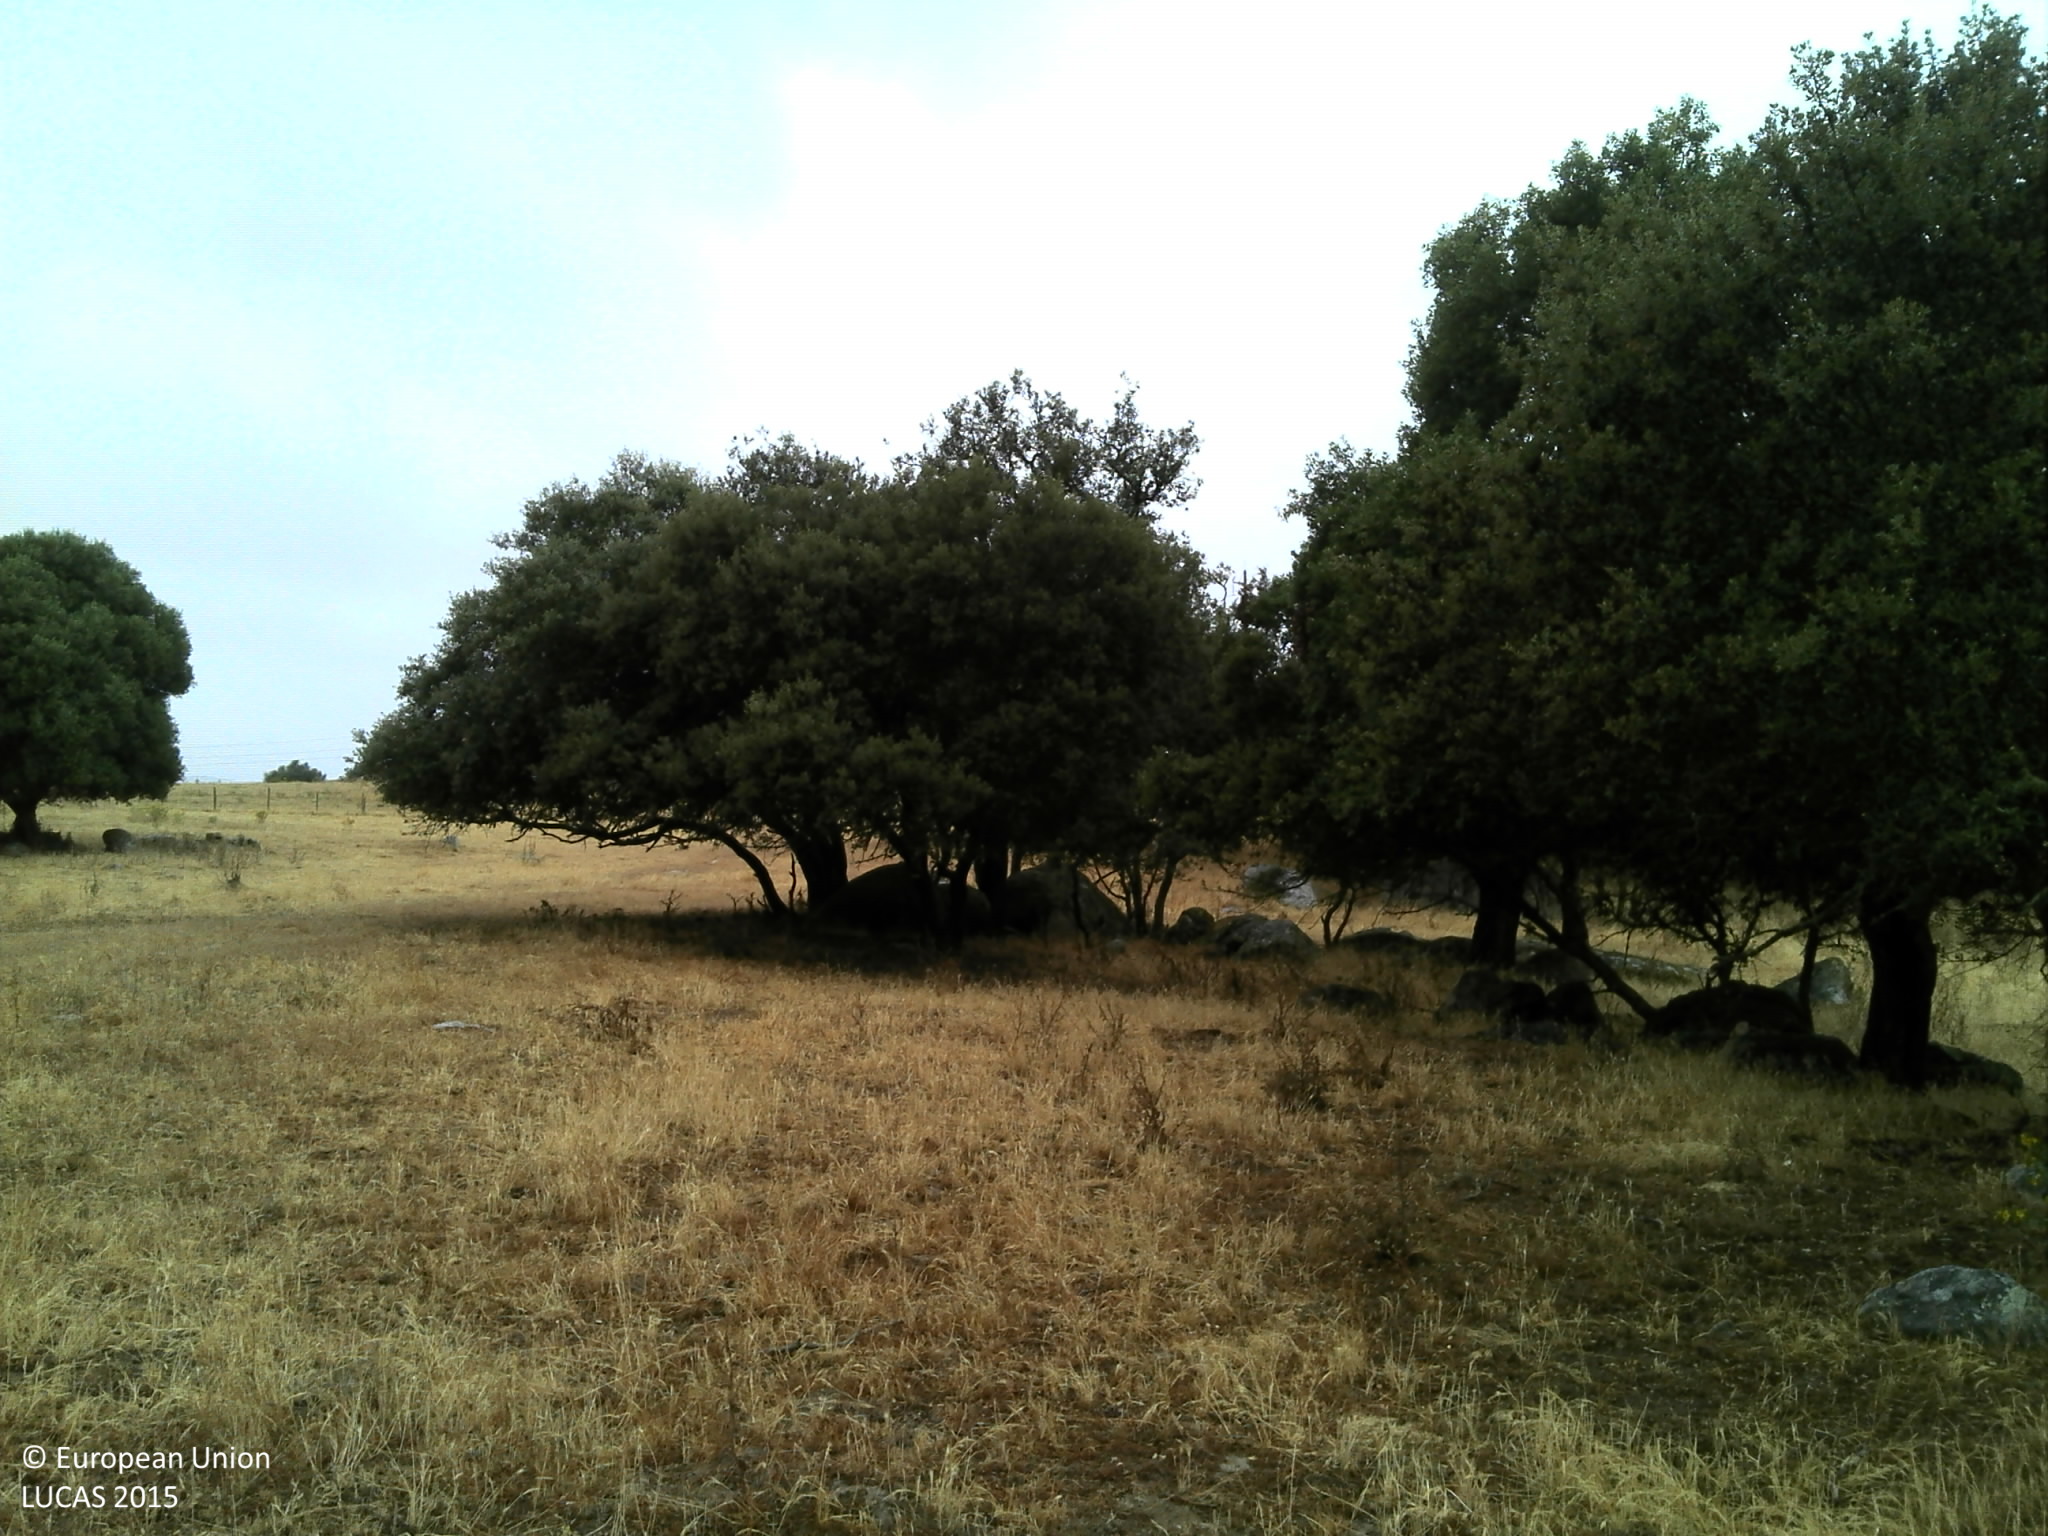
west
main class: Woodland
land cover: Broadleaved woodland
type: broadleaved evergreen forest
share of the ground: 25 - 50 %
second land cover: Grassland without tree/shrub cover
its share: 25 - 50 %
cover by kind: unconsolidated bare surface 40 %, broadleaved forest trees 30 %, herbaceous plants 30 %
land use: Forestry
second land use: Agriculture (excluding fallow land and kitchen gardens)
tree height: > 5 m
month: June
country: PT
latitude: 38.3921
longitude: -7.9553
